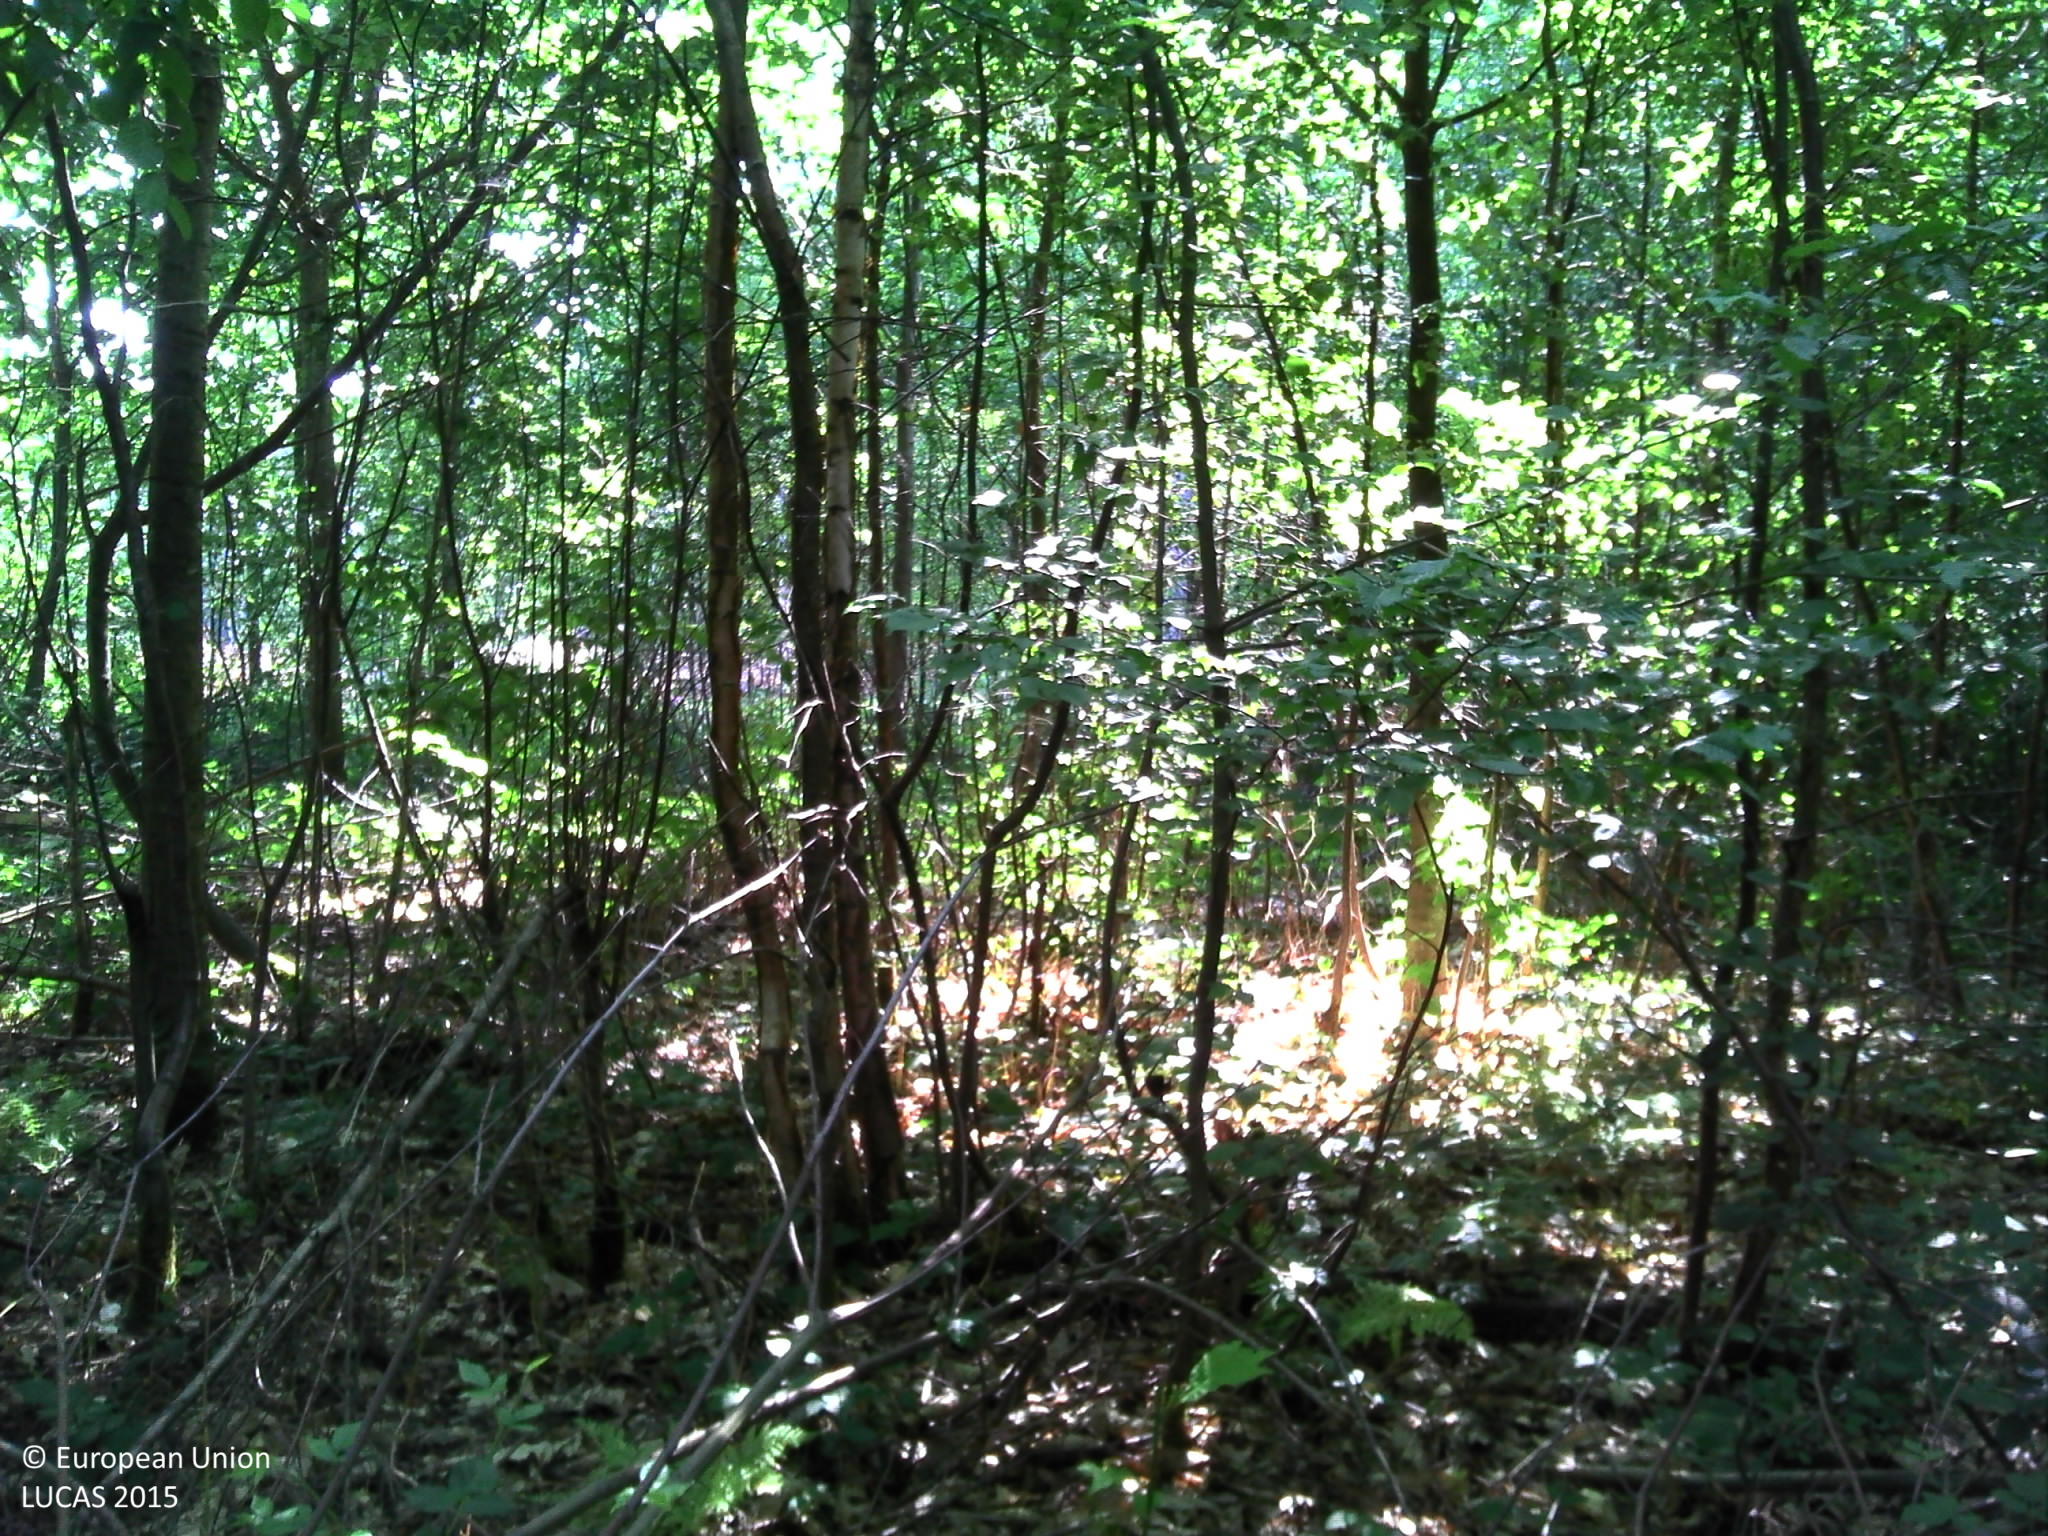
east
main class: Woodland
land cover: Broadleaved woodland
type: exotic forest
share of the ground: > 75 %
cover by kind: broadleaved forest trees 85 %, herbaceous plants 10 %, unconsolidated bare surface 5 %
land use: Forestry
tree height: > 5 m
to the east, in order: Broadleaved woodland; Tracks; Spontaneously vegetated surfaces; Broadleaved woodland; Tracks; Broadleaved woodland; Tracks; Spontaneously vegetated surfaces; Broadleaved woodland
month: July
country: BE
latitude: 50.2876
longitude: 4.5363
